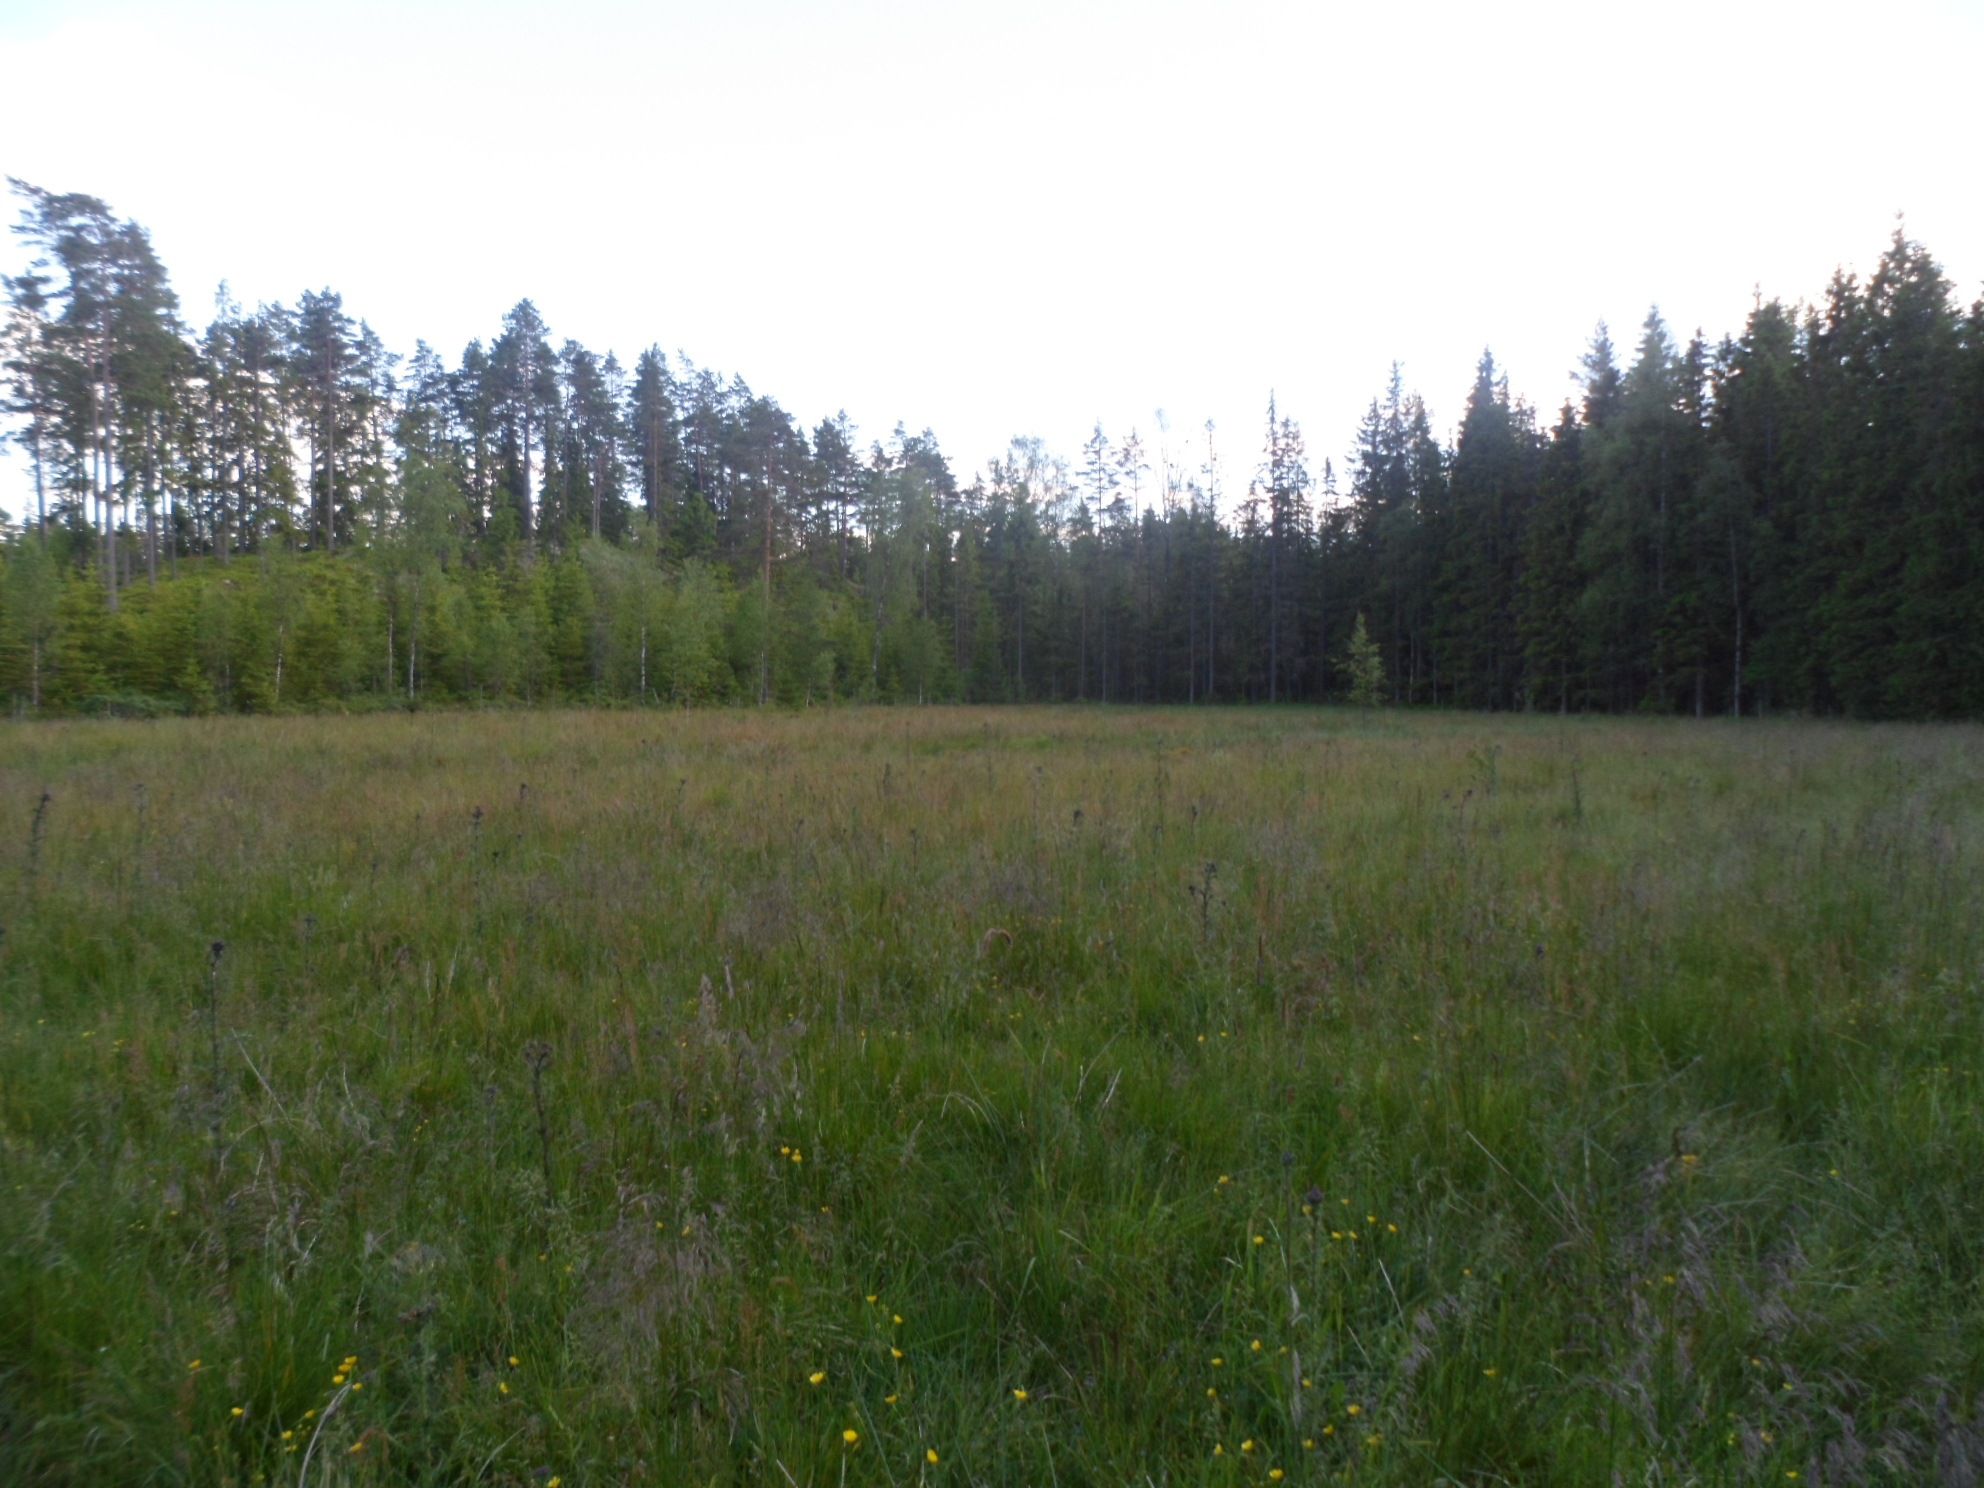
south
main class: Grassland
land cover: Grassland without tree/shrub cover
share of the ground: > 75 %
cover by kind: herbaceous plants 100 %
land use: Agriculture (excluding fallow land and kitchen gardens)
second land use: Amenities, museums, leisure
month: July
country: SE
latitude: 57.5713
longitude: 14.3928
